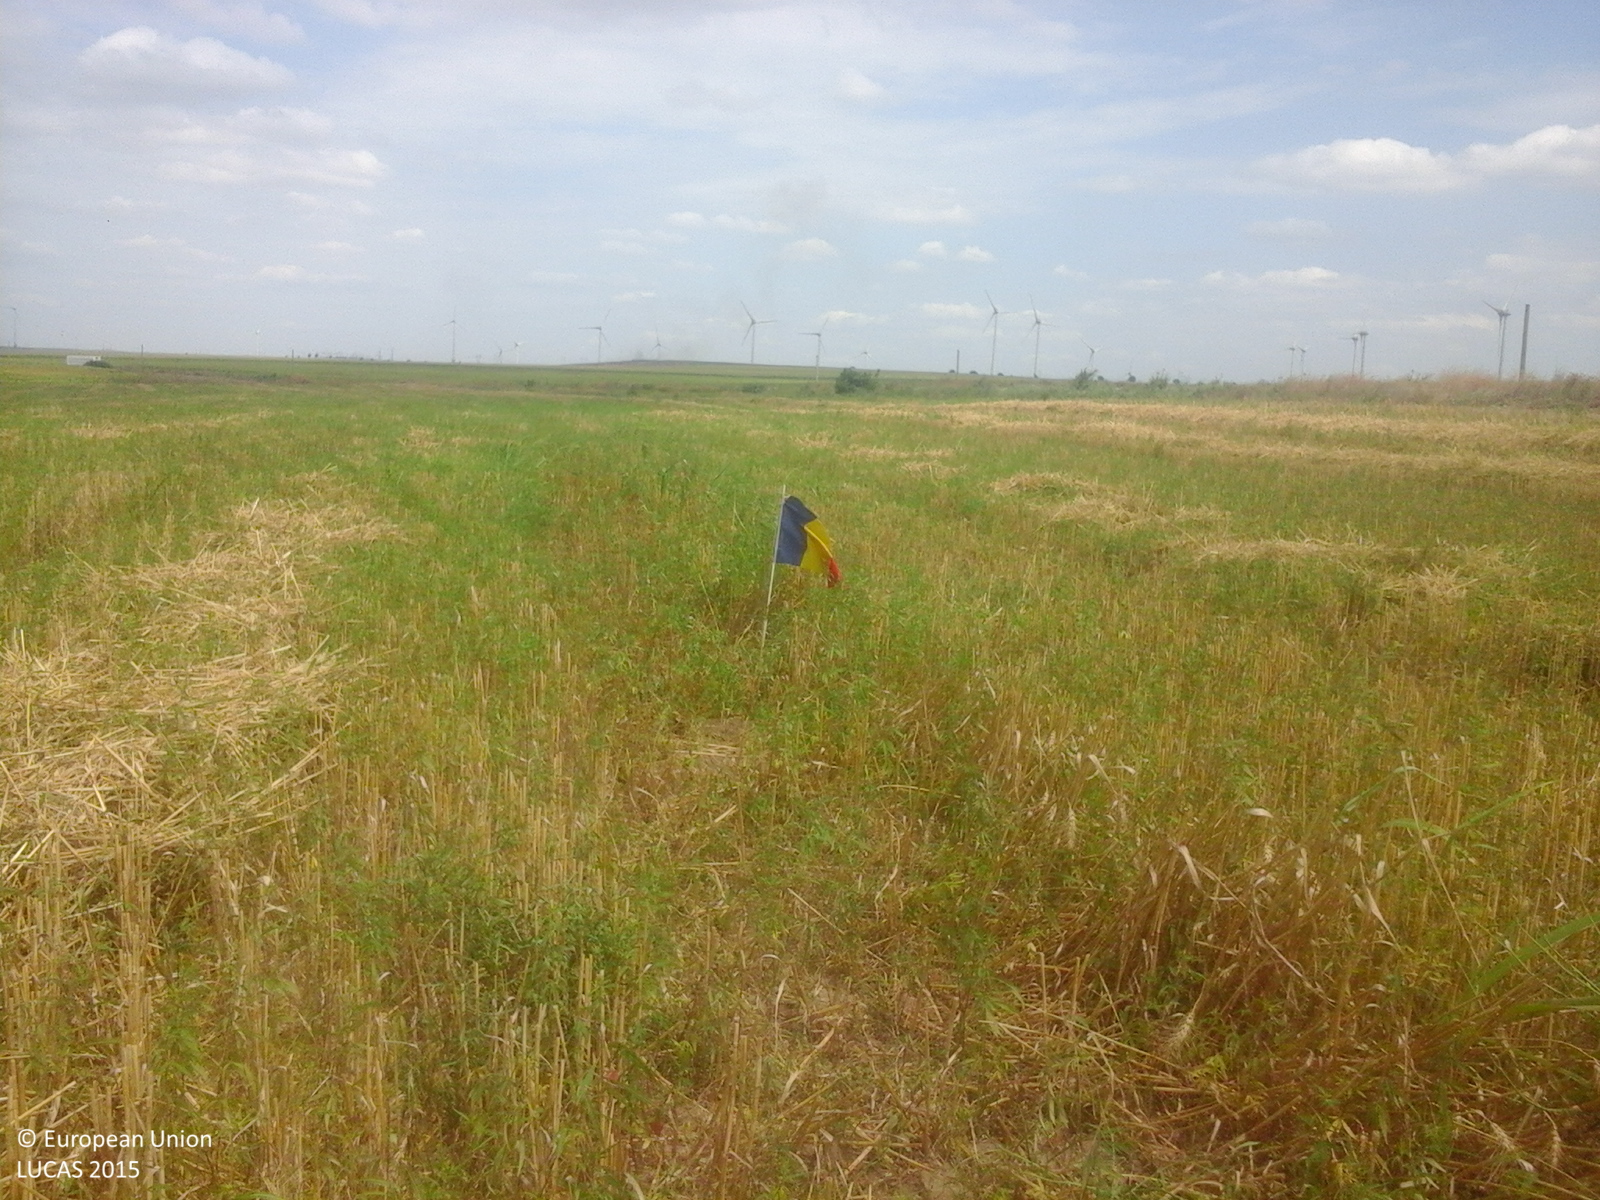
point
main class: Cropland
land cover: Common wheat
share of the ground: 25 - 50 %
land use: Agriculture (excluding fallow land and kitchen gardens)
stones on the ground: < 10 %
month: August
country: RO
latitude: 44.7727
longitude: 28.1989
